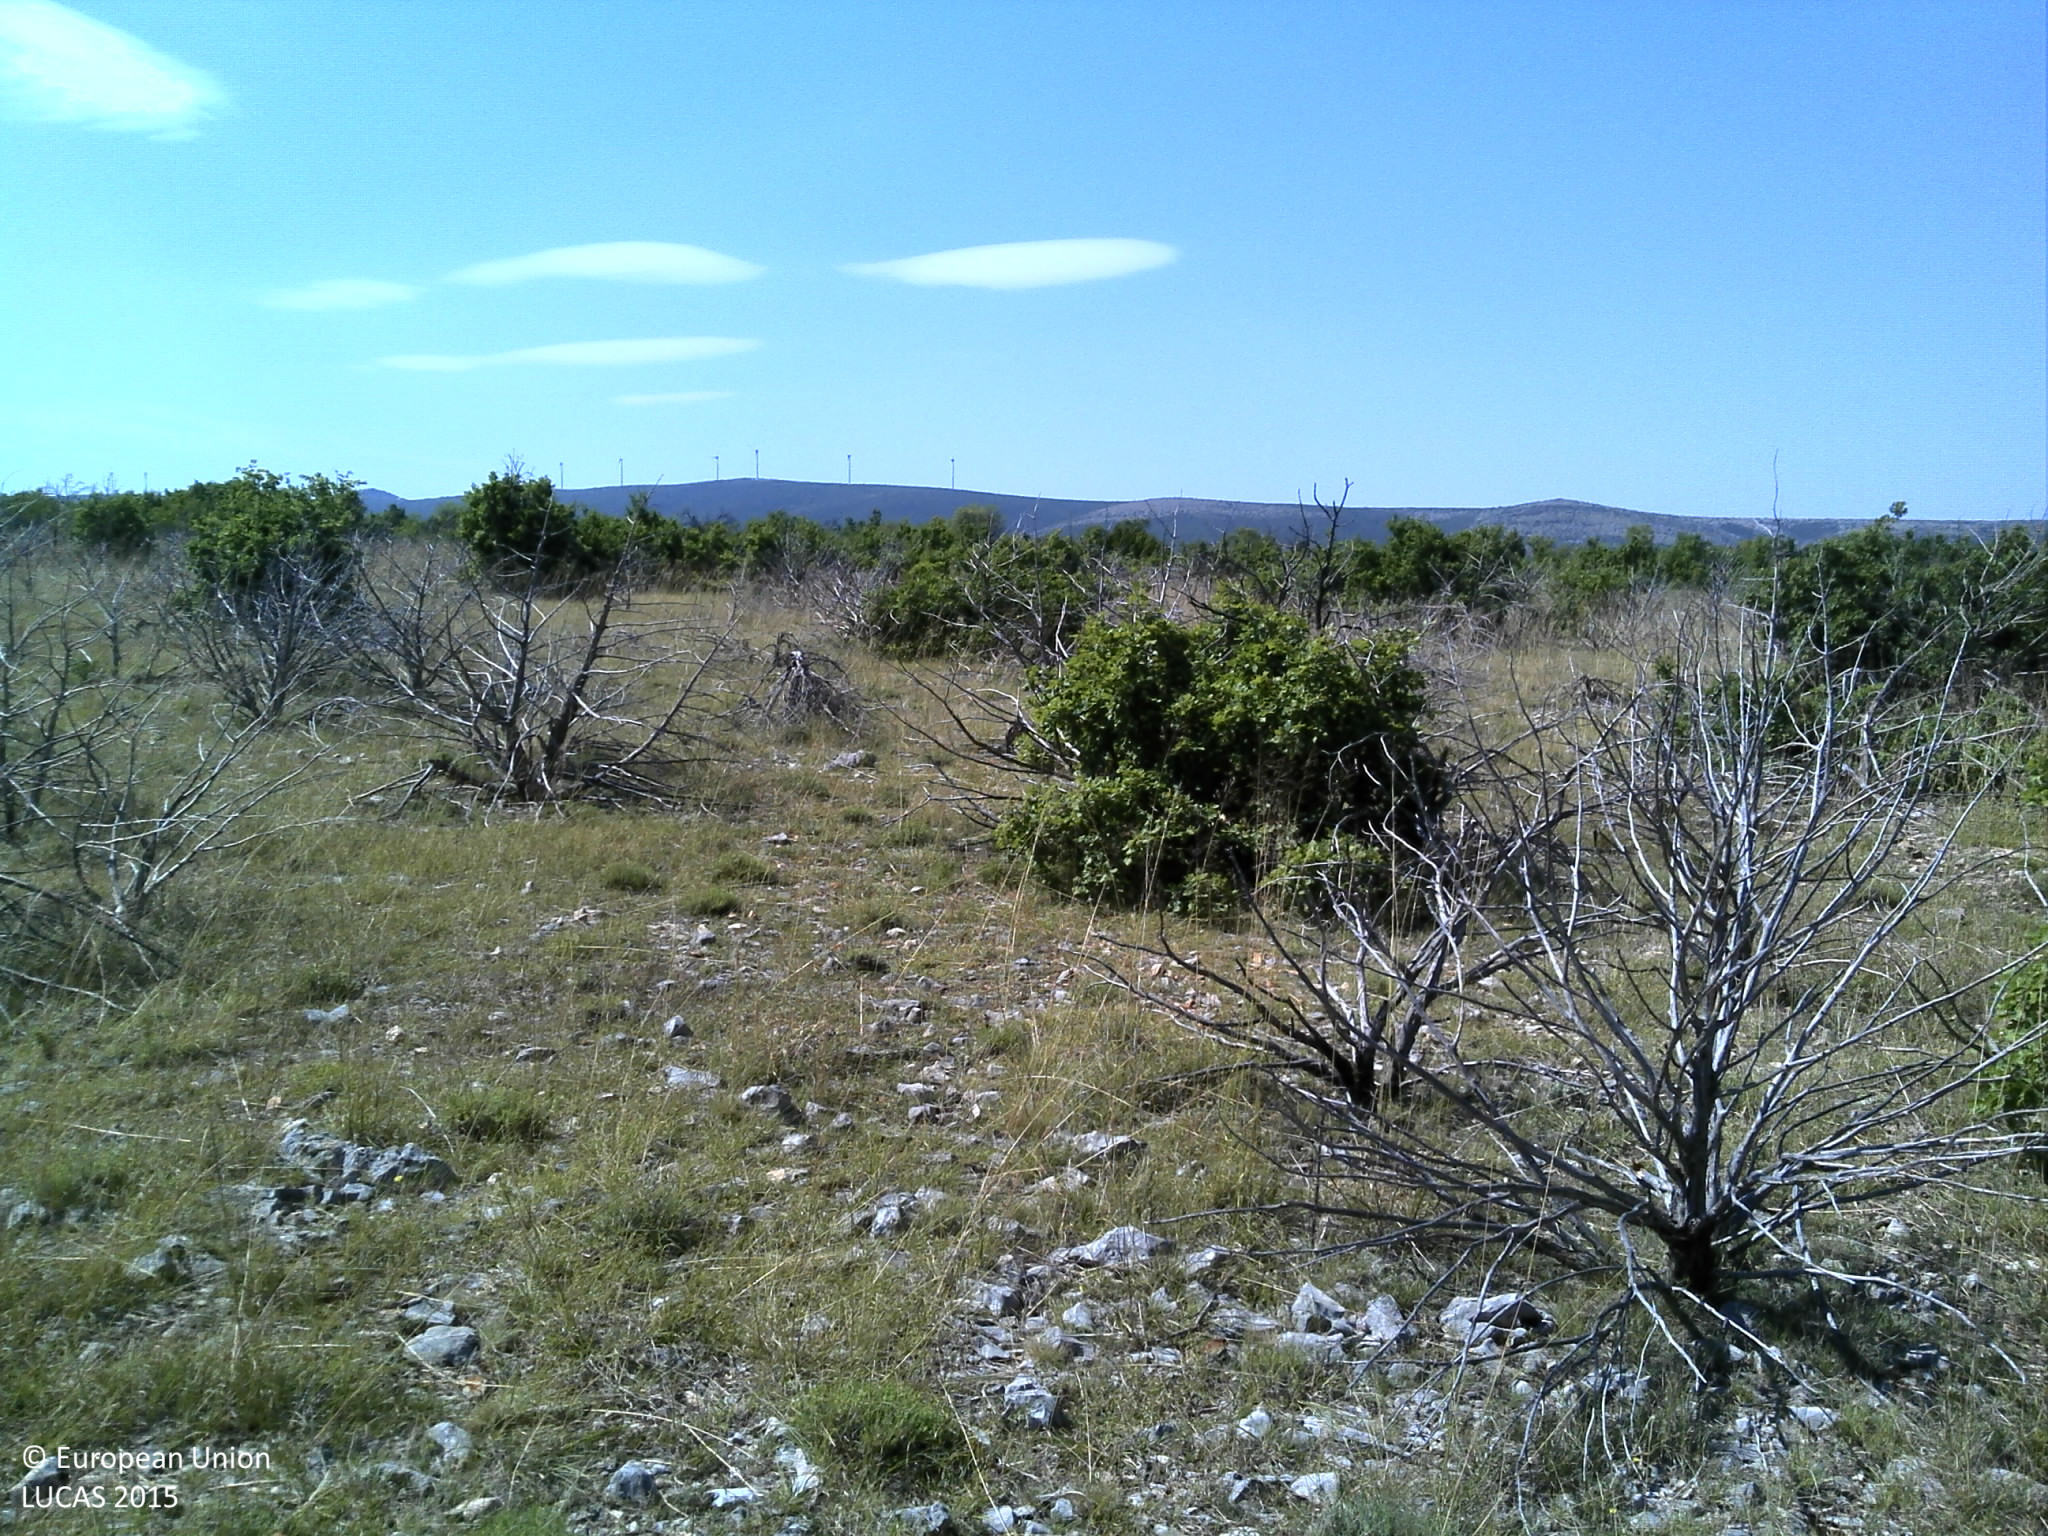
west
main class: Shrubland
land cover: Shrubland without tree cover
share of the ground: 25 - 50 %
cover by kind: herbaceous plants 40 %, shrubs 30 %, unconsolidated bare surface 25 %, consolidated bare surface 5 %
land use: Semi-natural and natural areas not in use
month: July
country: HR
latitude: 43.7931
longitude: 16.0686
